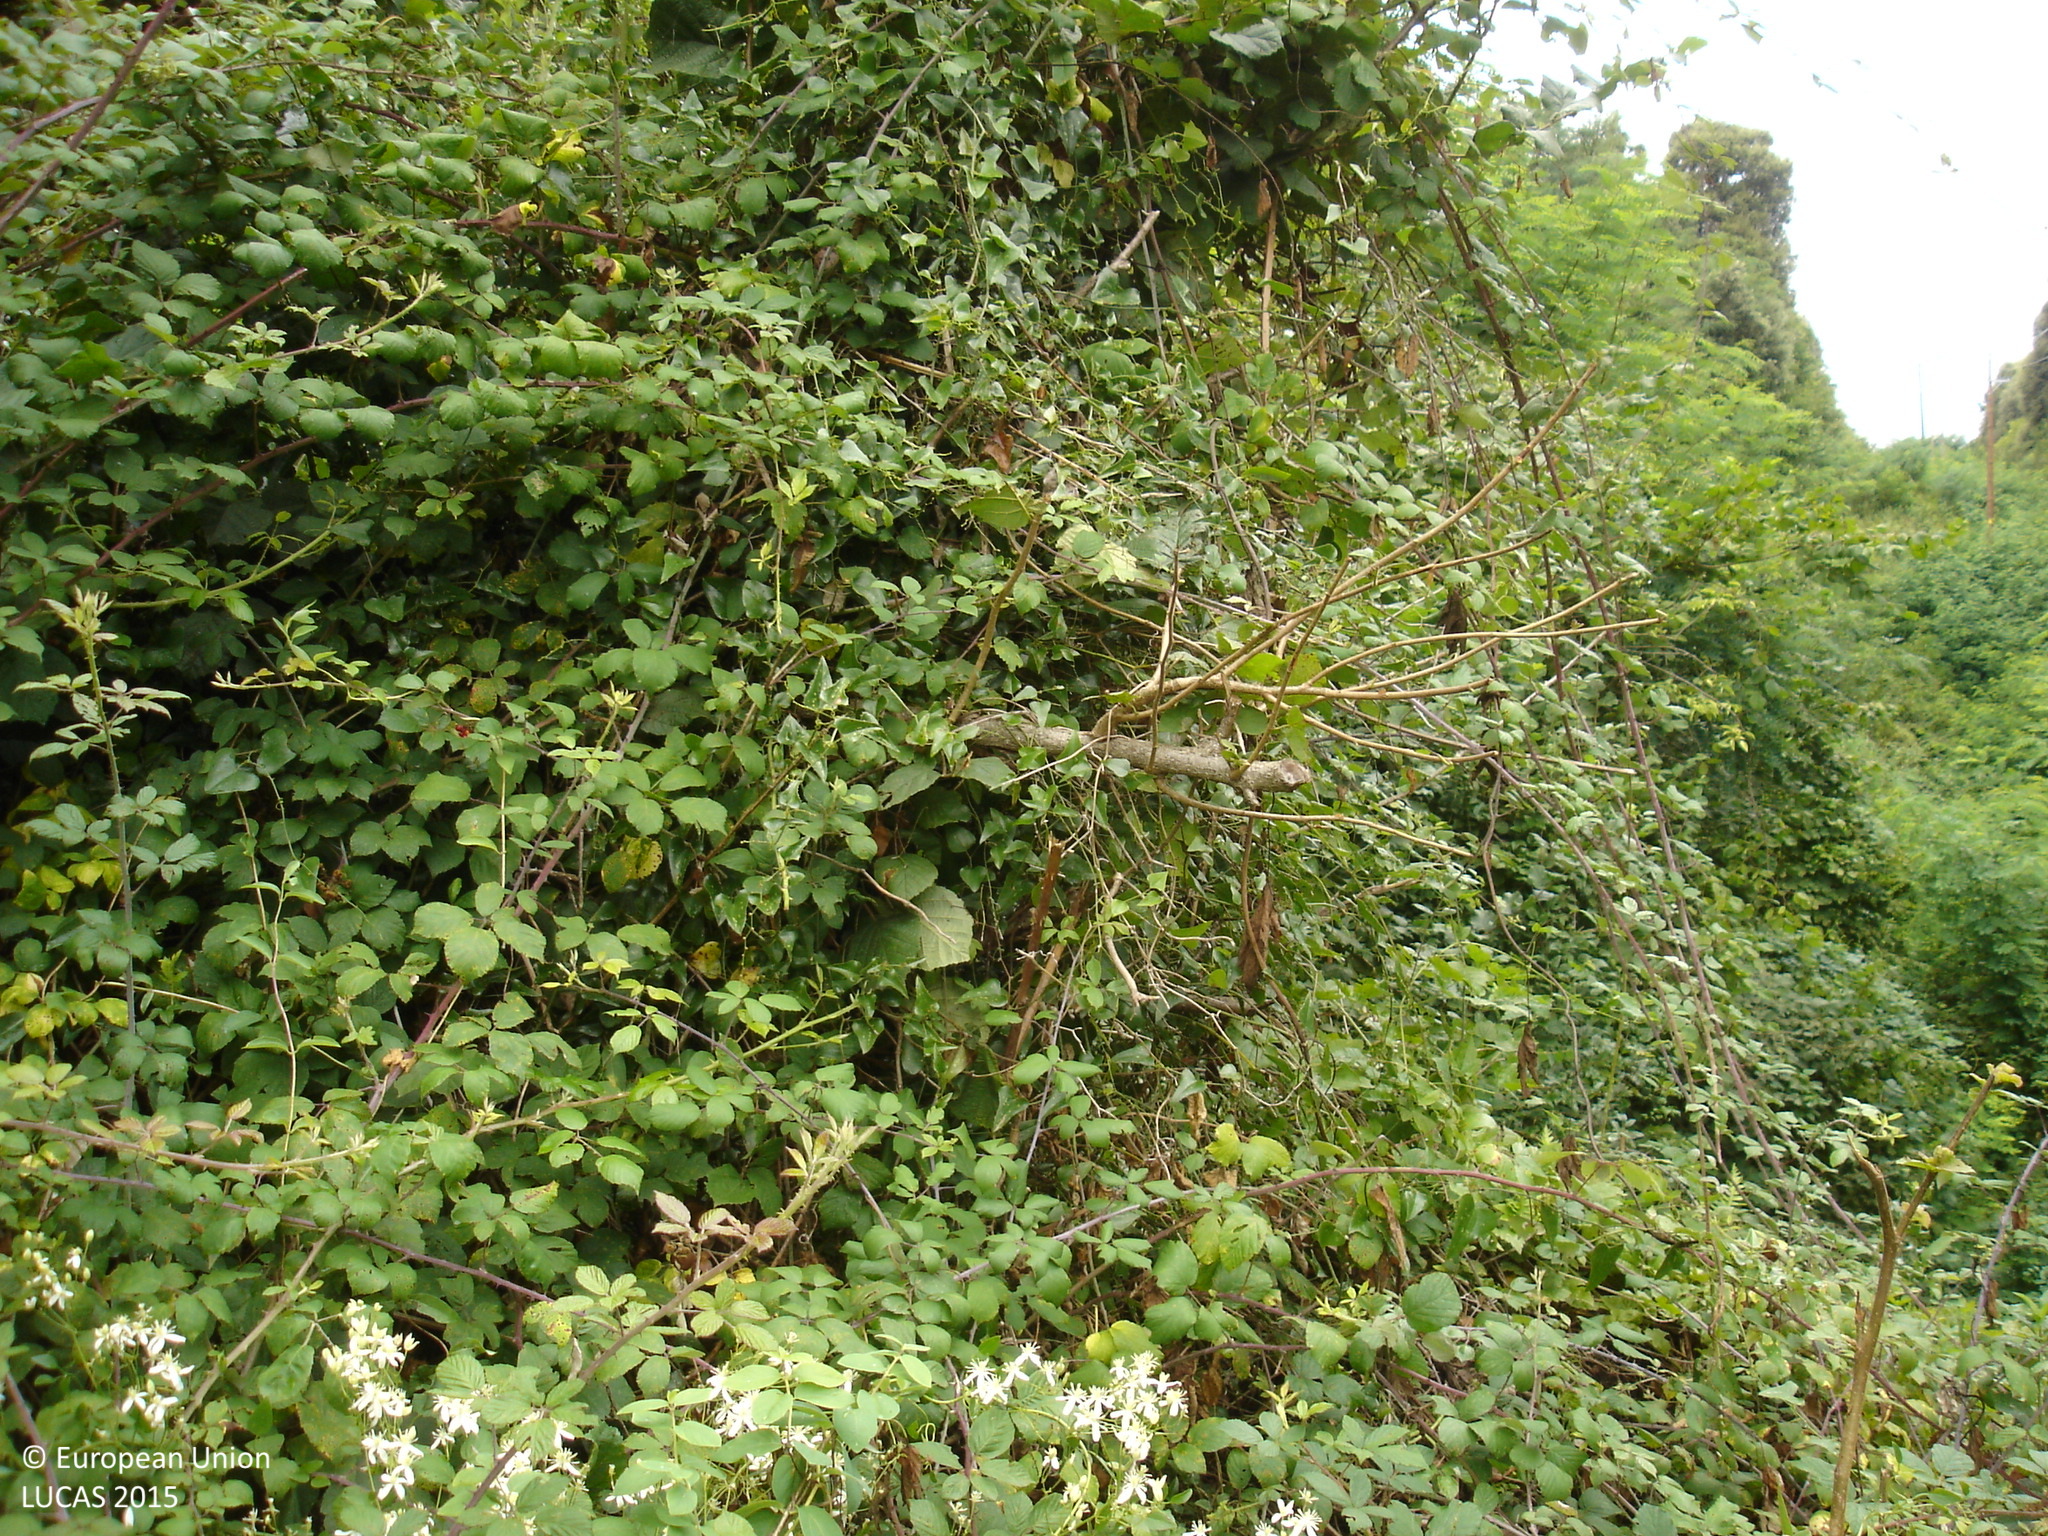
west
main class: Woodland
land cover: Broadleaved woodland
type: thermophilous deciduous forest
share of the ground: > 75 %
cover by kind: broadleaved forest trees 80 %, shrubs 20 %
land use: Forestry
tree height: > 5 m
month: July
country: ES
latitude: 42.1616
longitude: 2.5463
